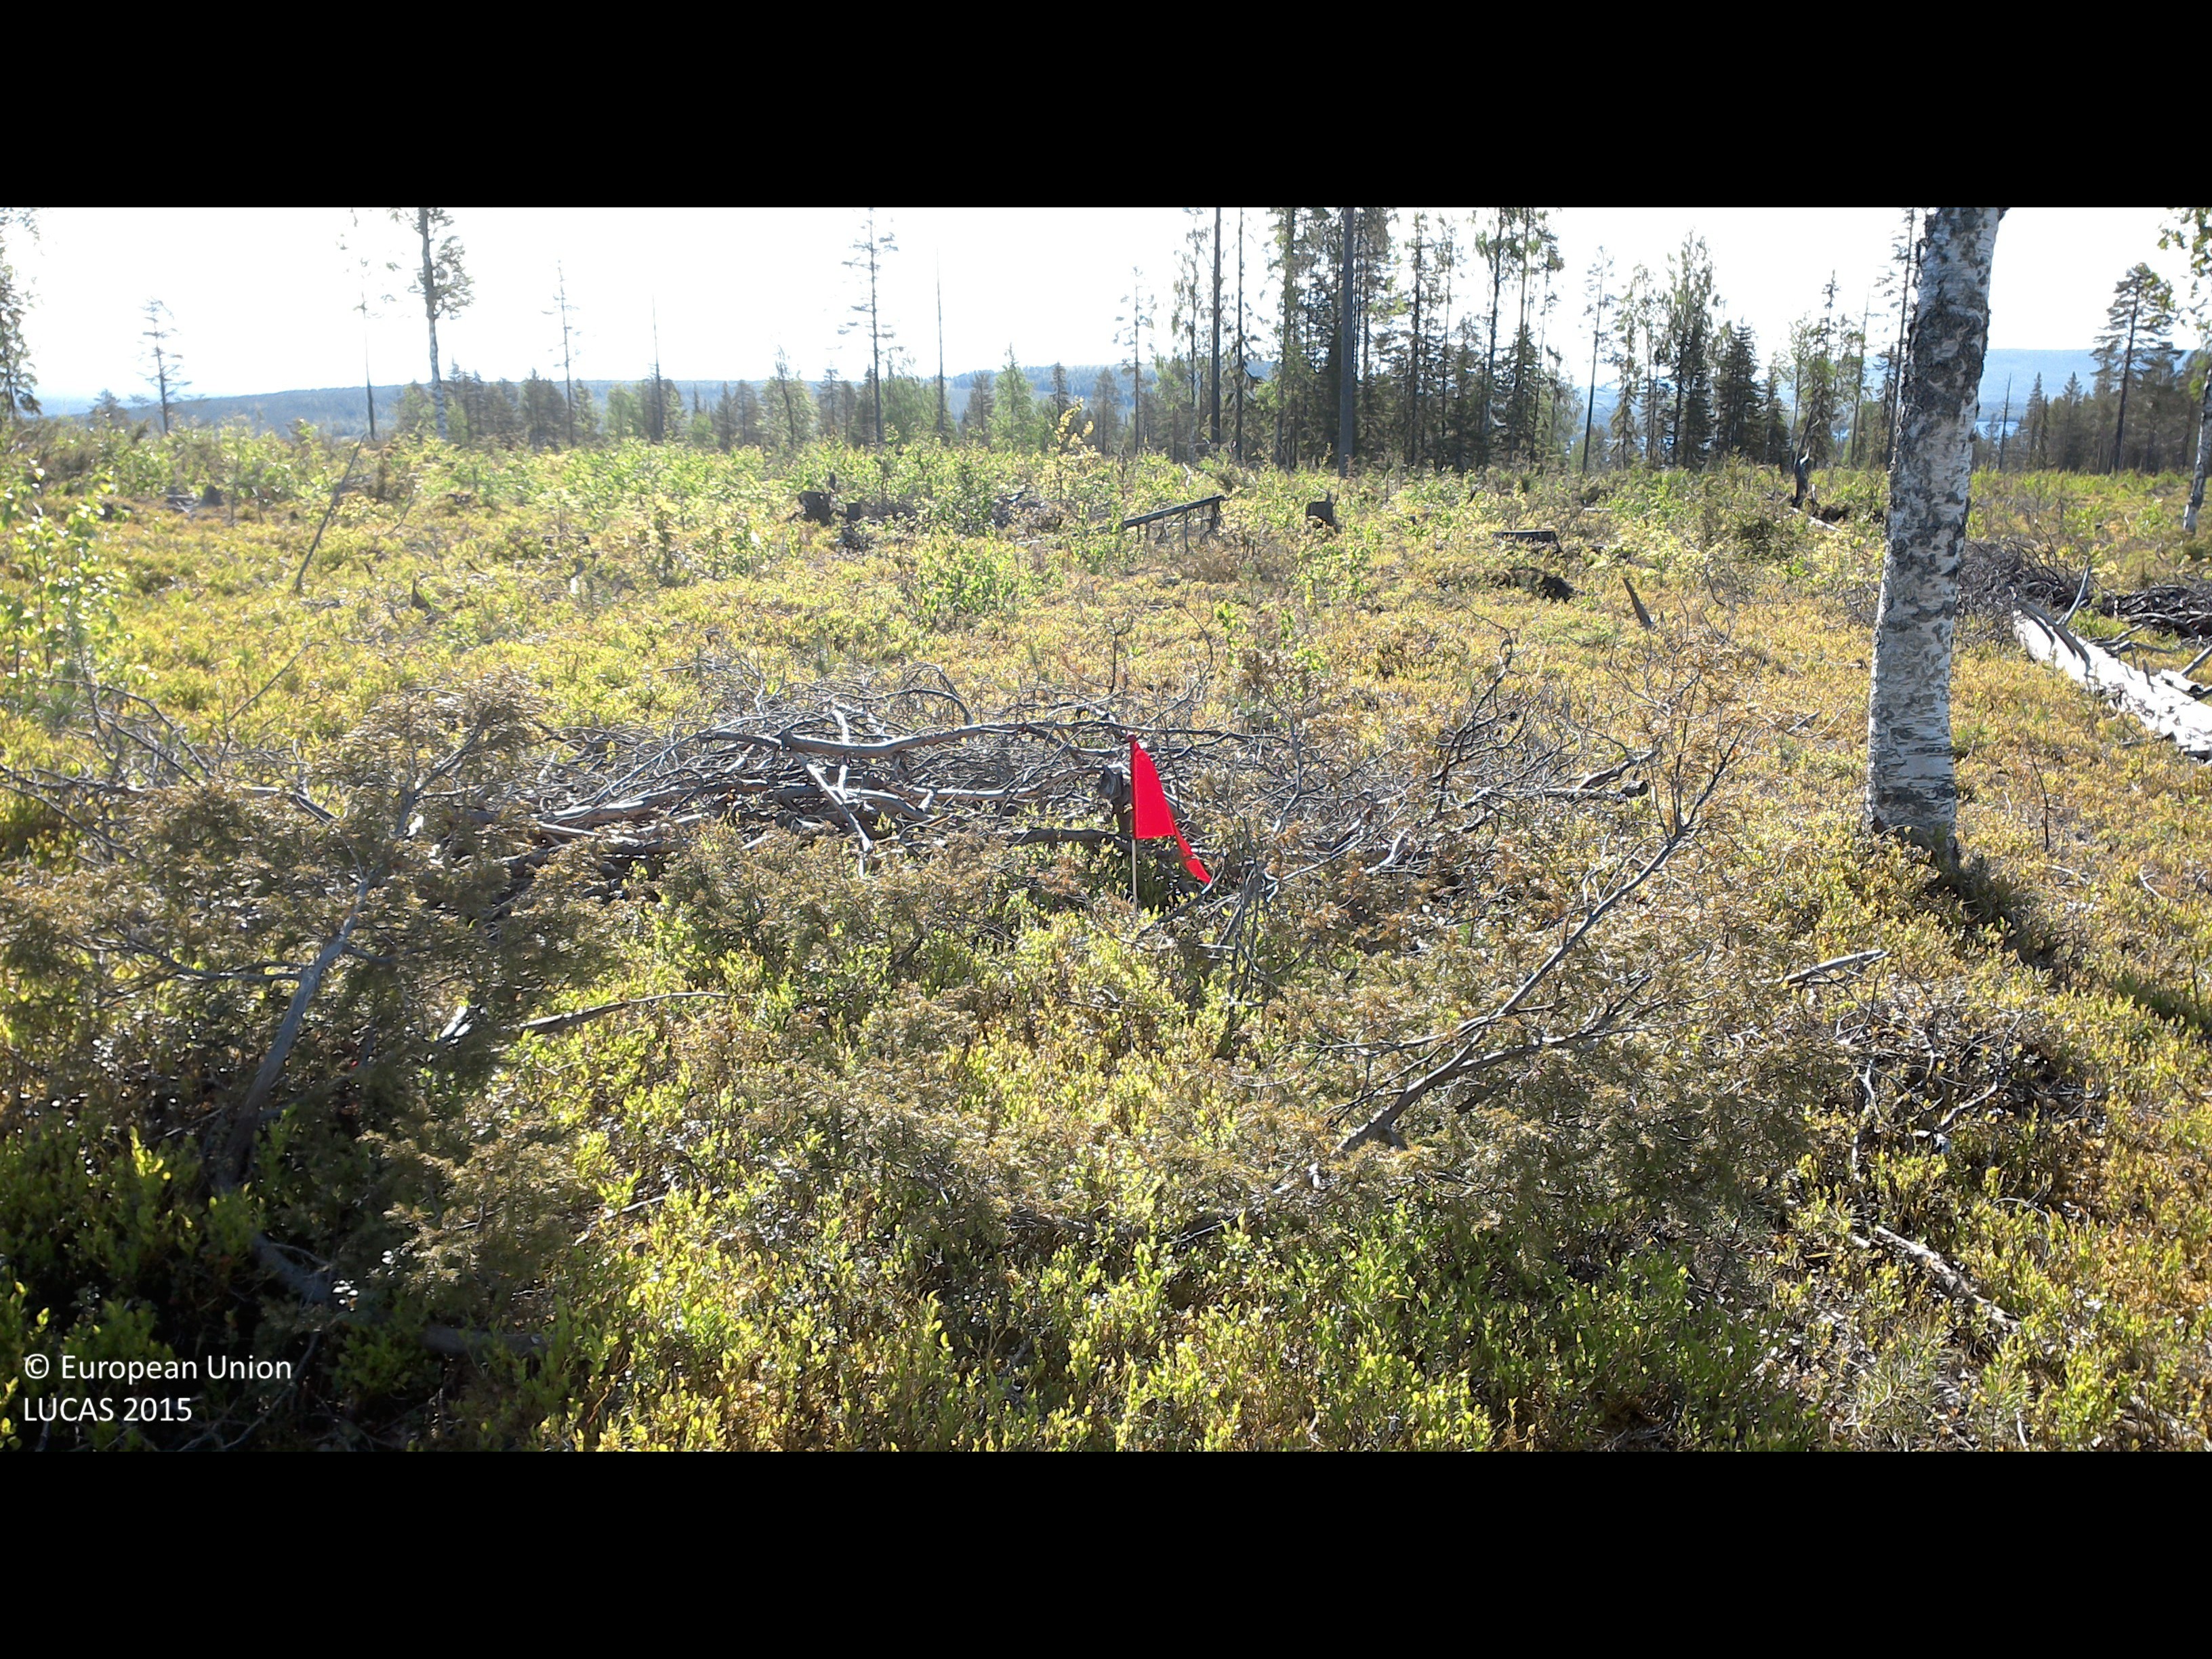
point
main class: Woodland
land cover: Broadleaved woodland
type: boreal forest
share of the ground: 10 - 25 %
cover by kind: shrubs 85 %, broadleaved forest trees 10 %, lichens and mosses 5 %
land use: Forestry
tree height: < 5 m
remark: Clear cut
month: June
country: SE
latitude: 66.6860
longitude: 22.5822
